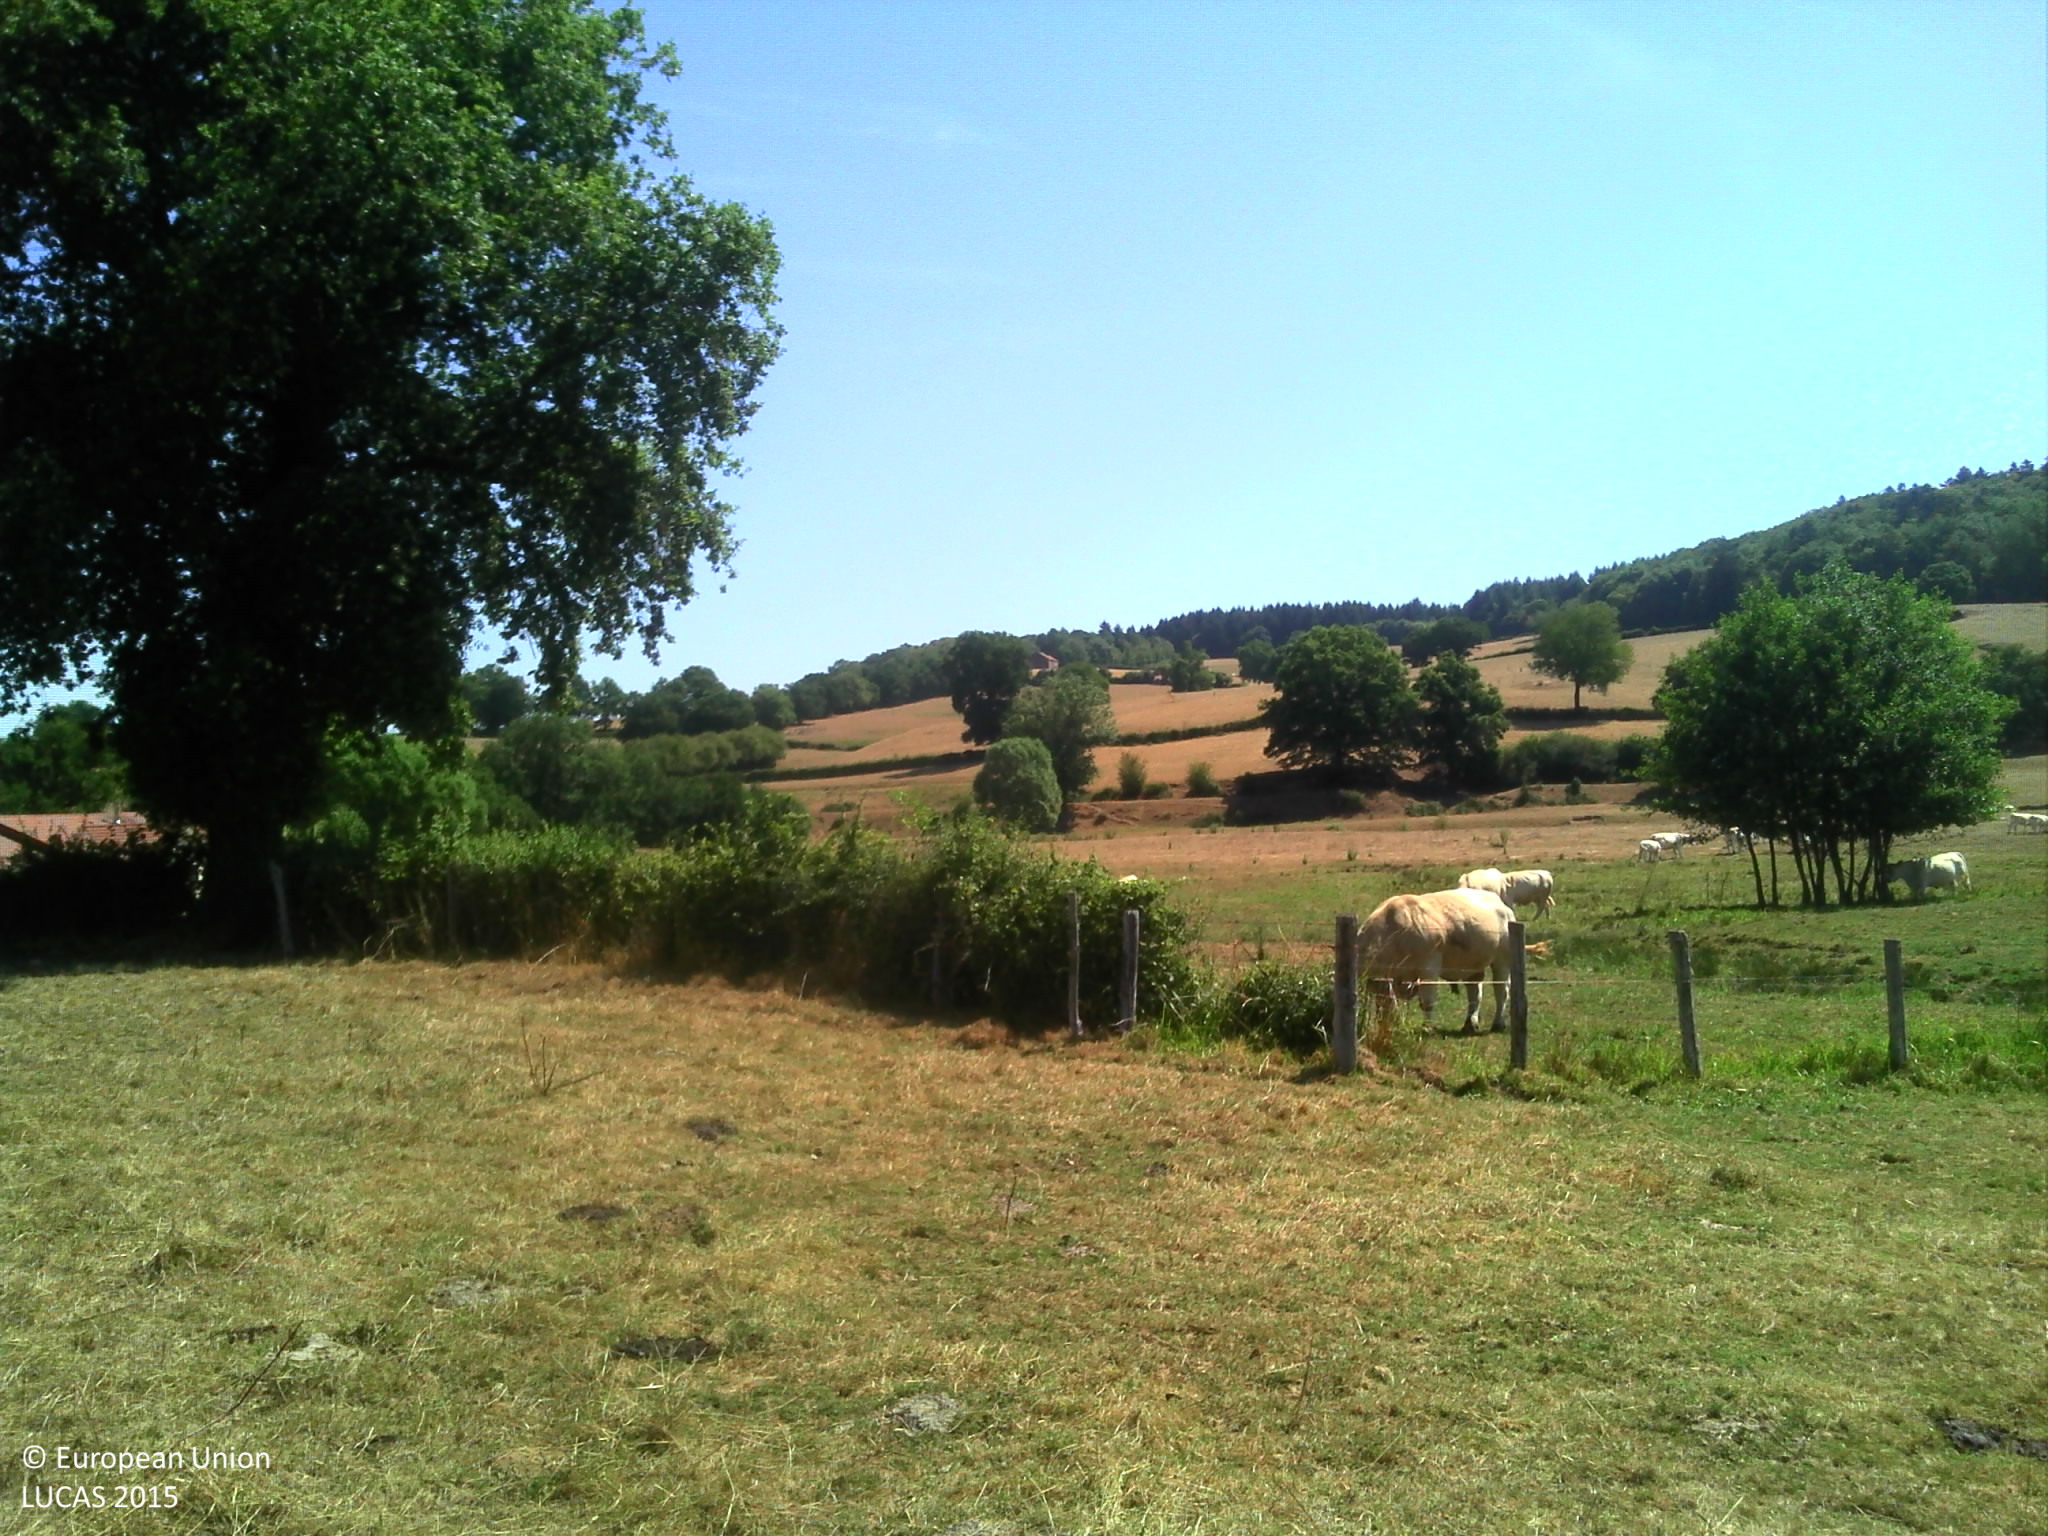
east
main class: Grassland
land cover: Grassland without tree/shrub cover
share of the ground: > 75 %
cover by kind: herbaceous plants 100 %
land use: Agriculture (excluding fallow land and kitchen gardens)
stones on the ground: 10 - 25 %
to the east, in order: Grassland without tree/shrub cover; Abandoned hedges; Fences; Grassland without tree/shrub cover; Rivers and streams; Grassland without tree/shrub cover; Fences; Grassland without tree/shrub cover
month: August
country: FR
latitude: 46.6775
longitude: 4.4710
